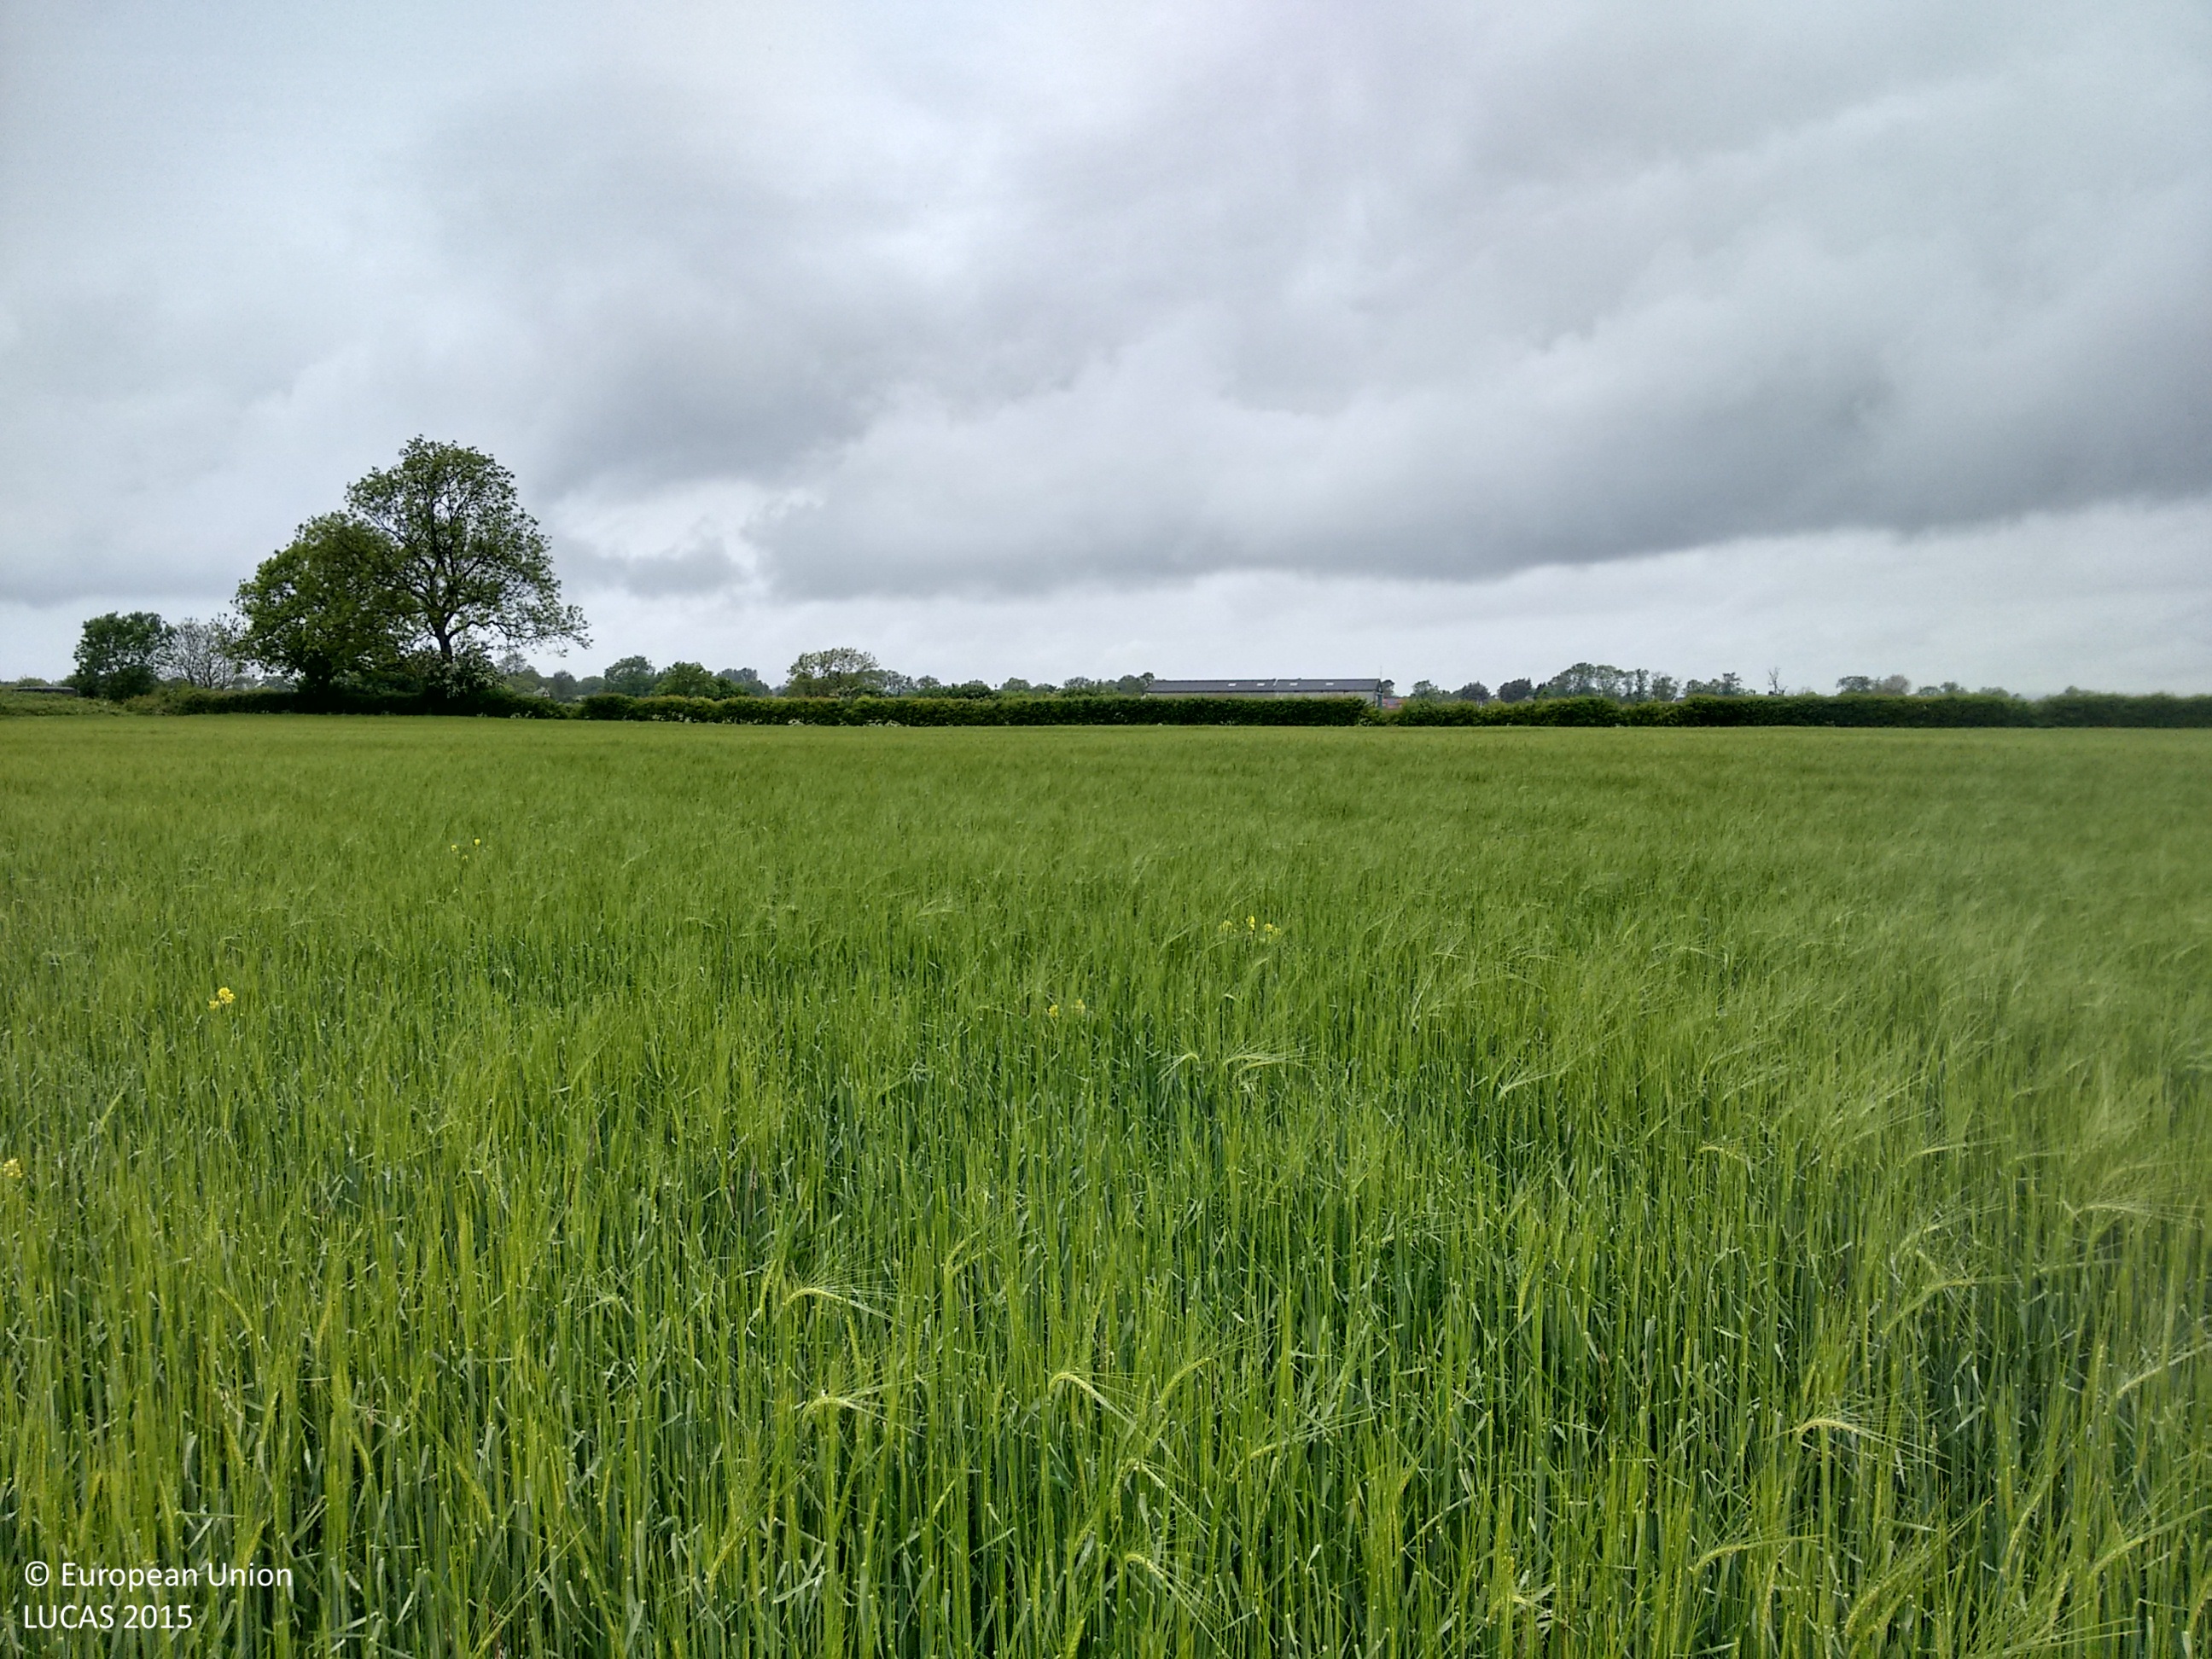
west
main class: Cropland
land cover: Barley
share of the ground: > 75 %
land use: Agriculture (excluding fallow land and kitchen gardens)
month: May
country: GB
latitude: 53.6854
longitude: -0.3161
